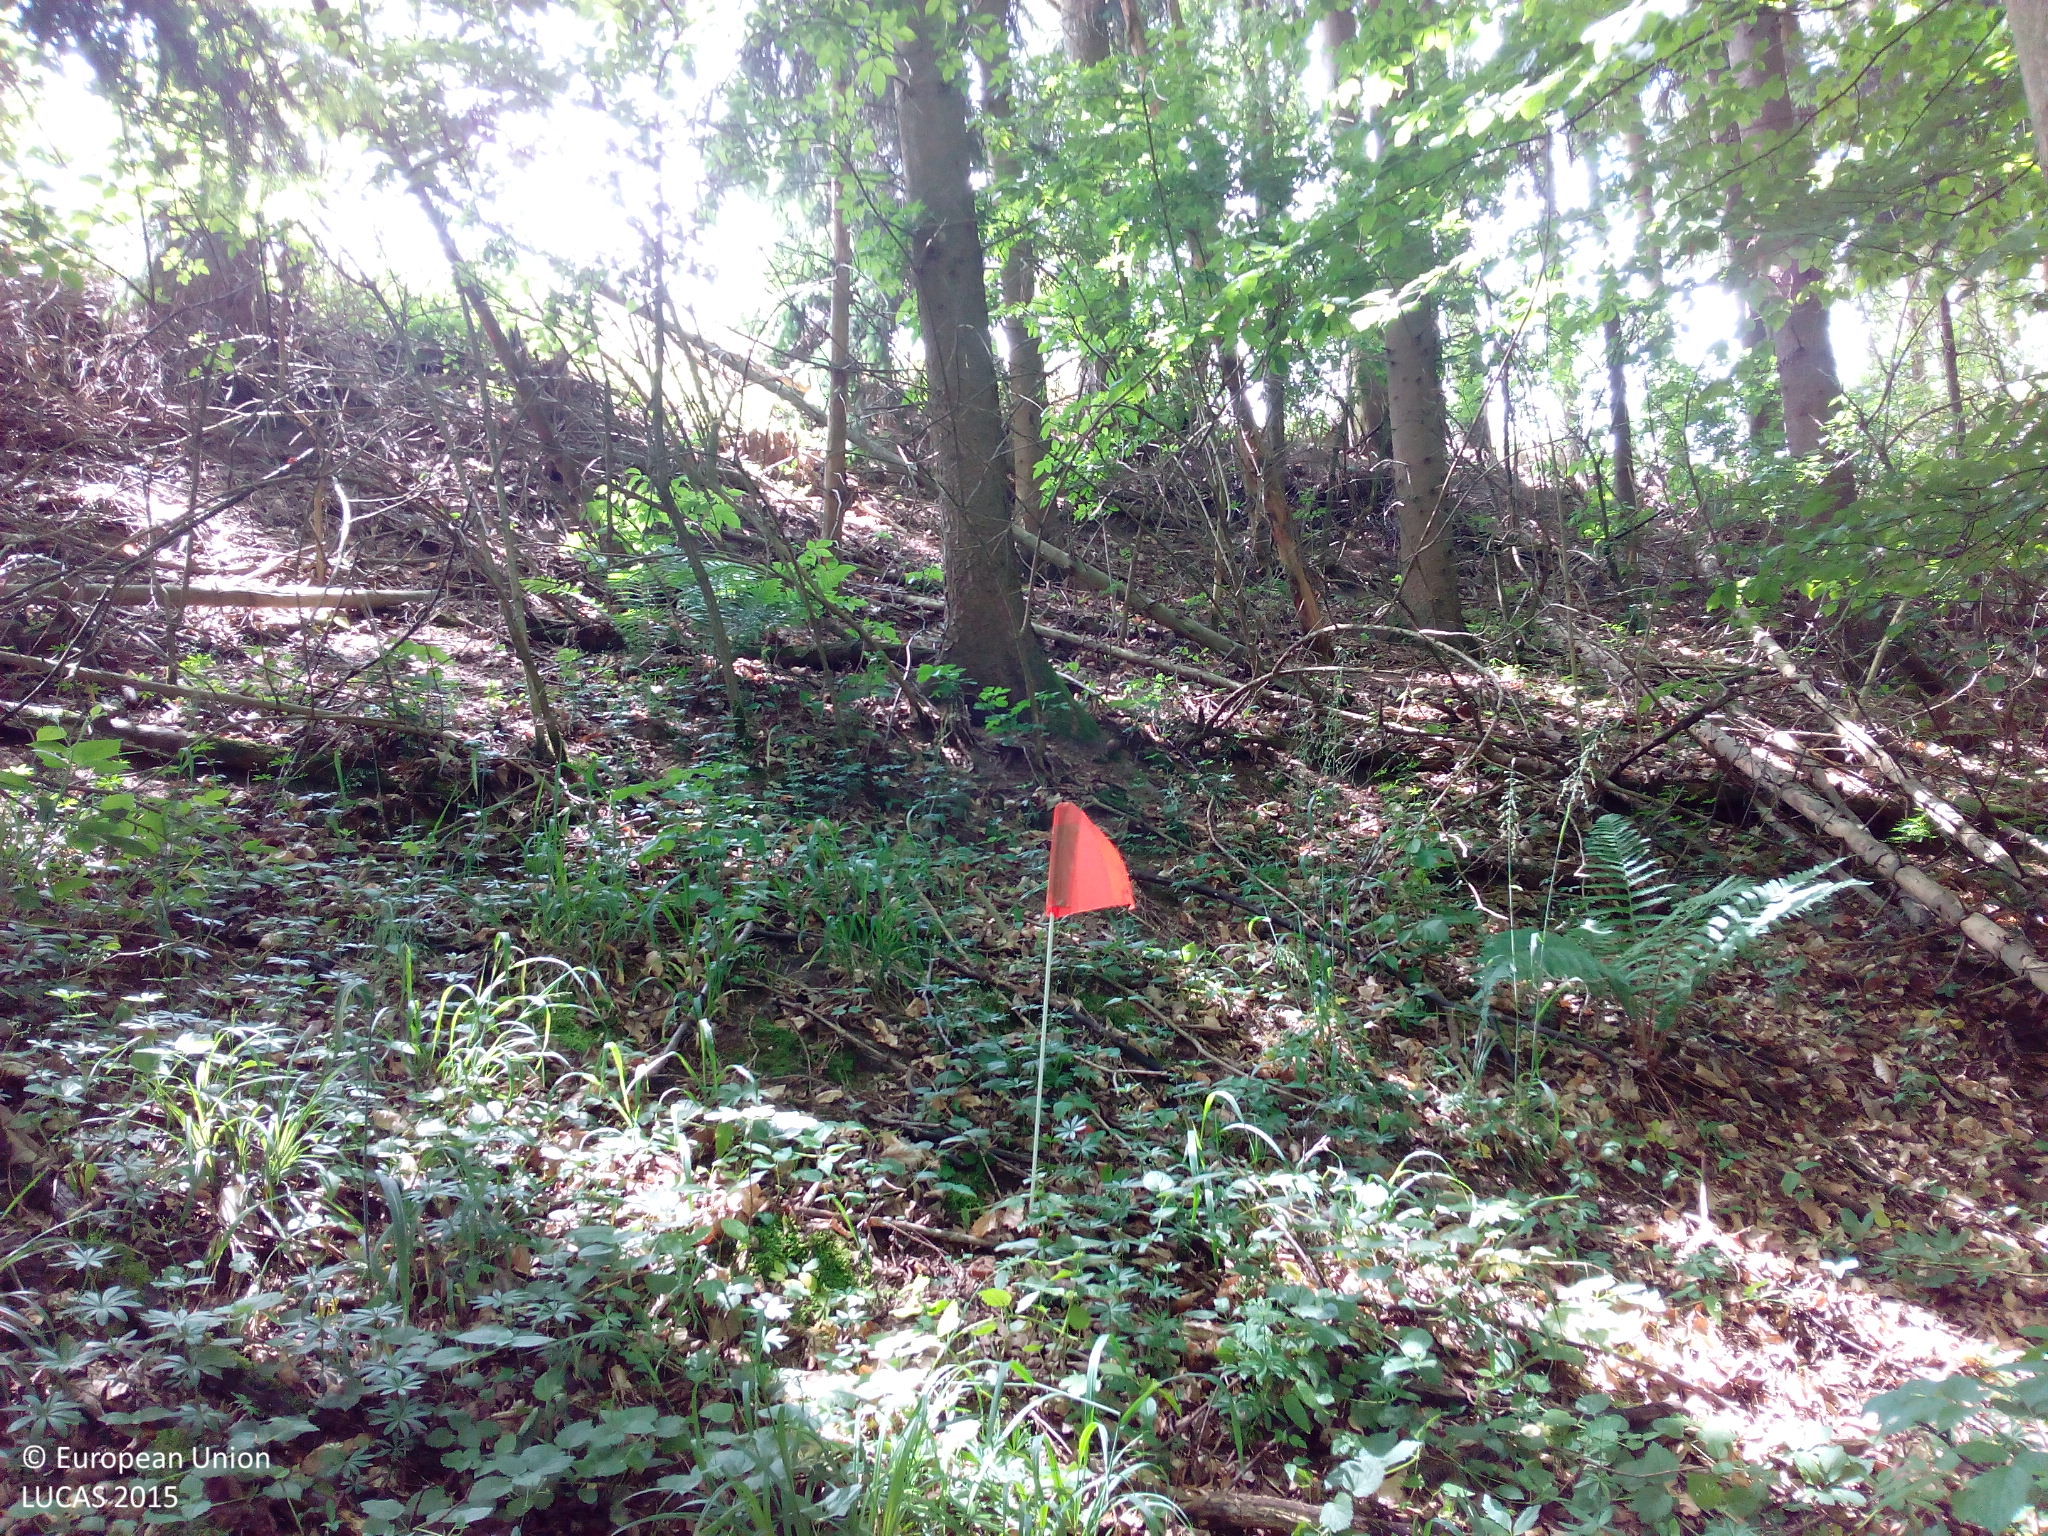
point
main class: Woodland
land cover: Broadleaved woodland
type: mesophytic deciduous forest
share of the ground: > 75 %
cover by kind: broadleaved forest trees 85 %, shrubs 10 %, coniferous forest trees 5 %
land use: Forestry
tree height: > 5 m
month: June
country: DE
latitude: 49.0495
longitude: 9.3846
